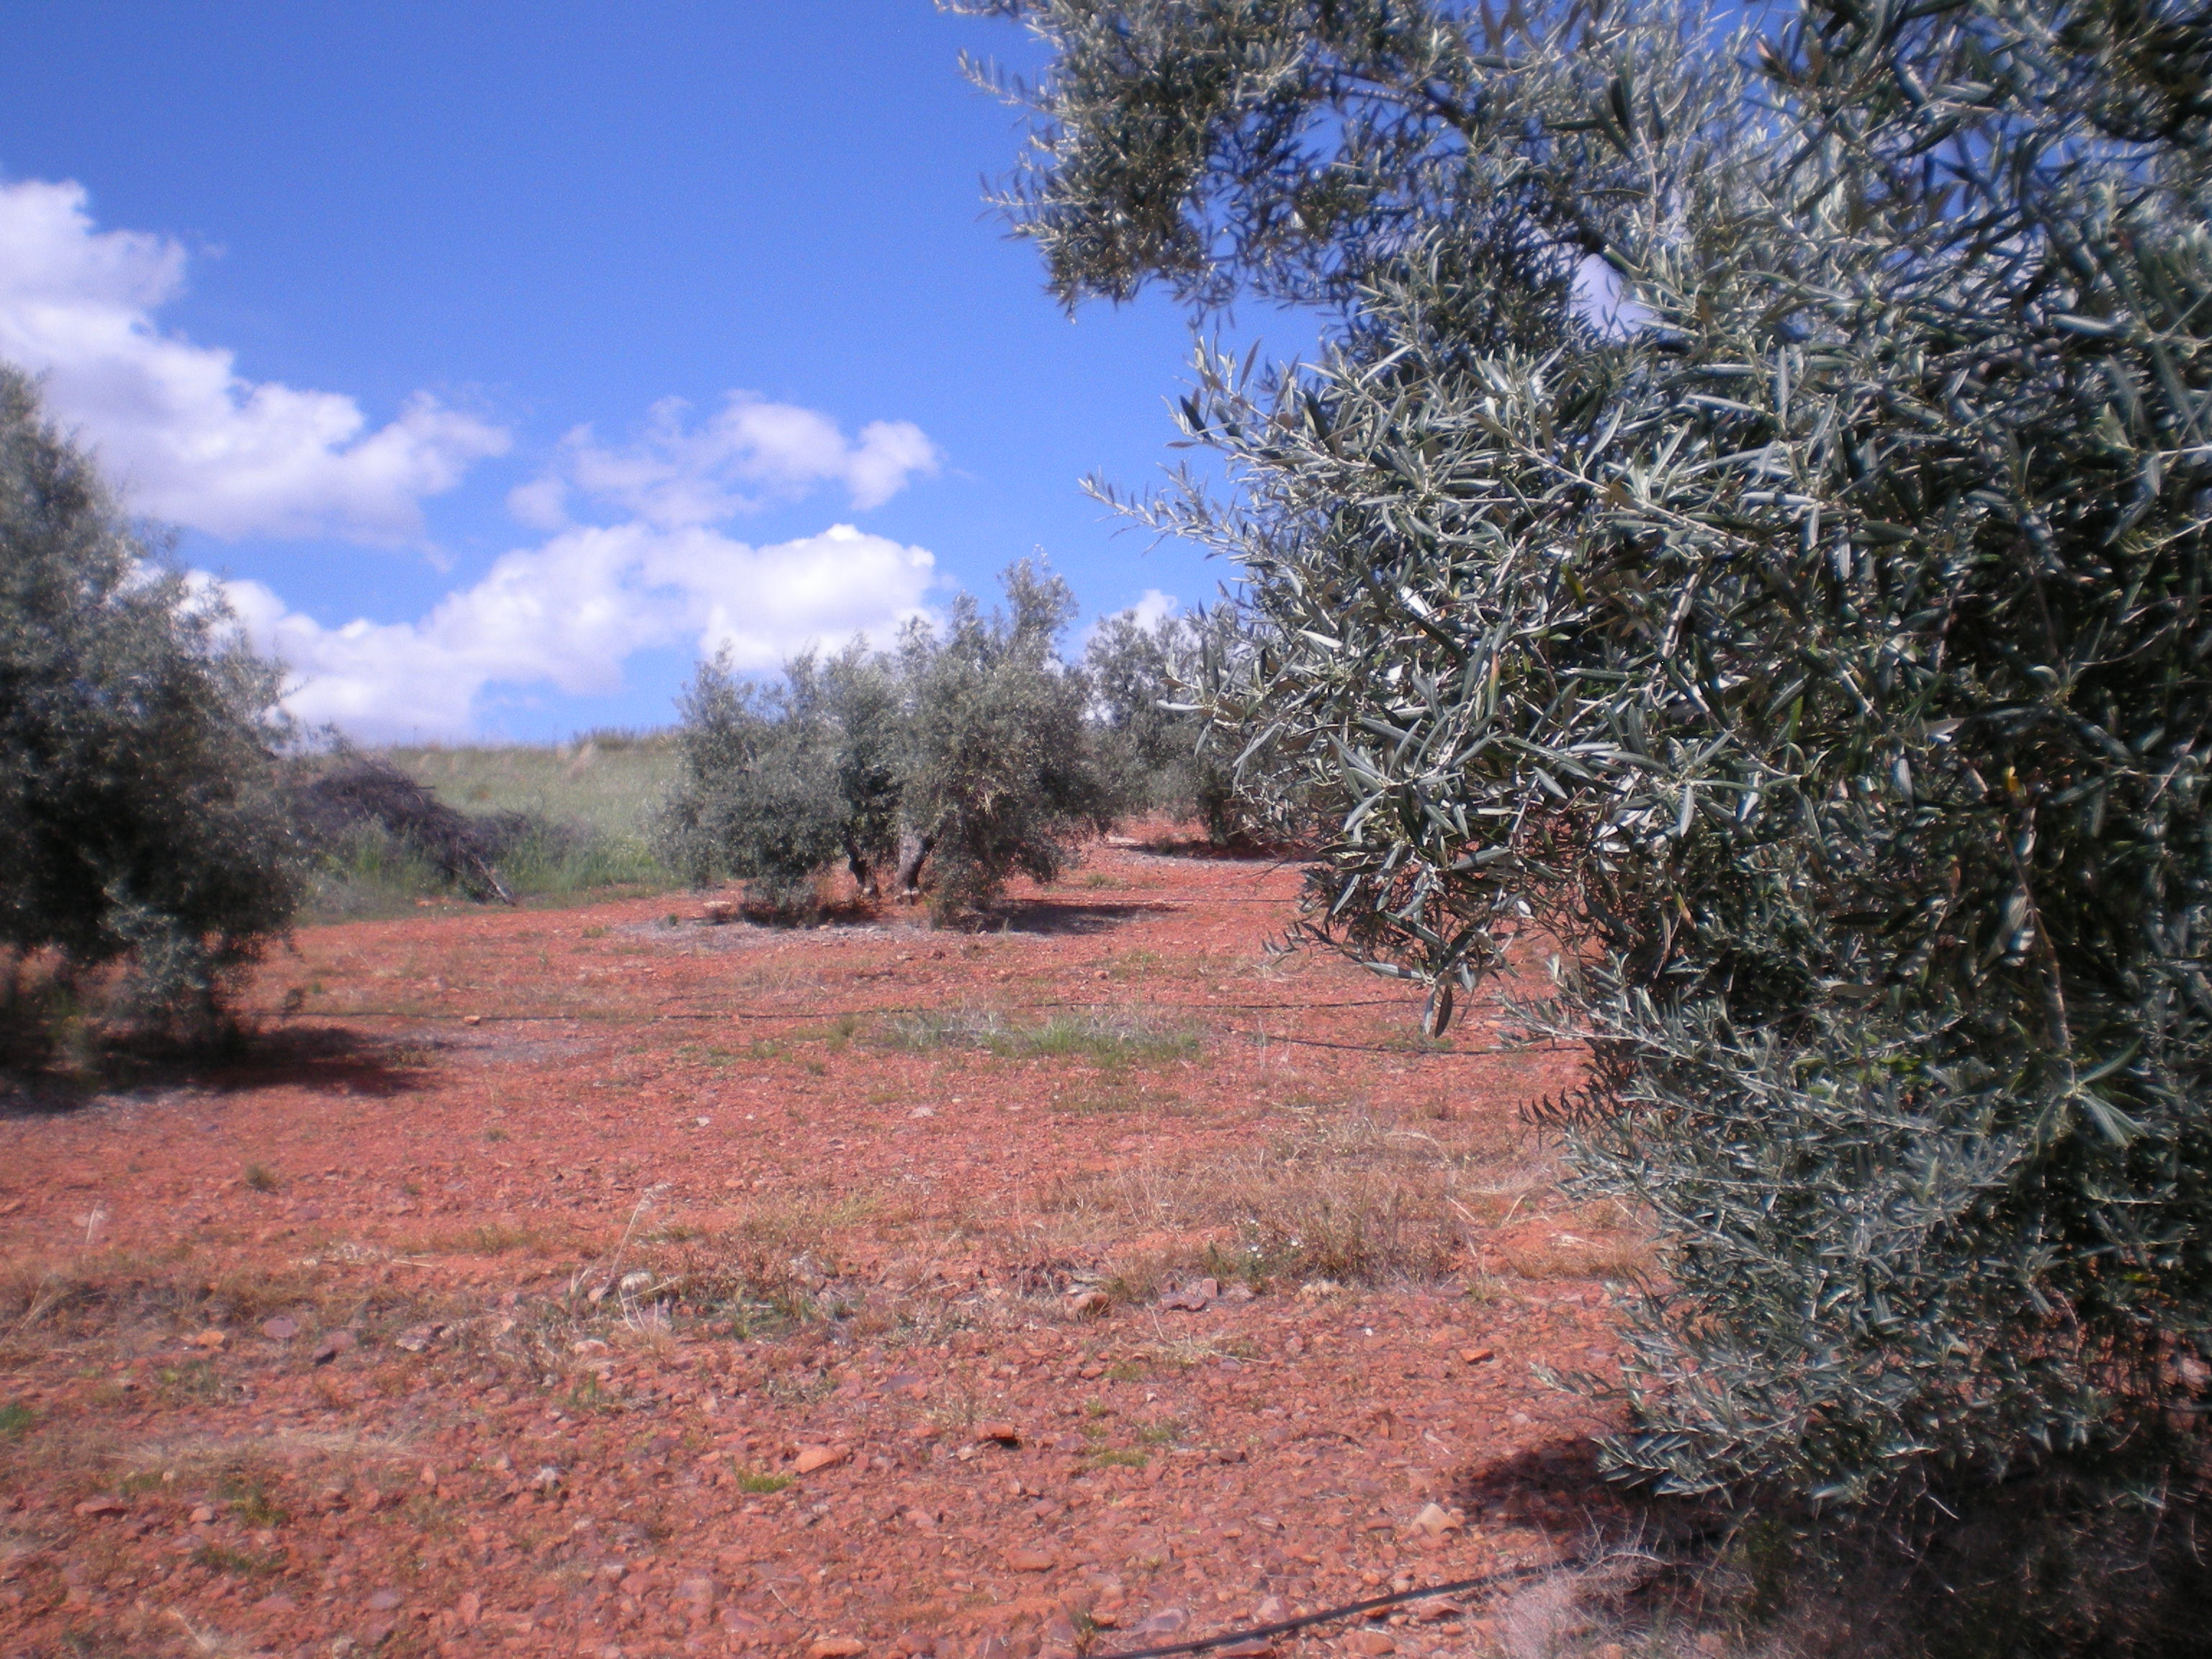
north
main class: Cropland
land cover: Olive groves
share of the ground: 25 - 50 %
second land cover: Other bare soil
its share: > 75 %
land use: Agriculture (excluding fallow land and kitchen gardens)
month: April
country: ES
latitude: 38.7567
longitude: -3.5337
